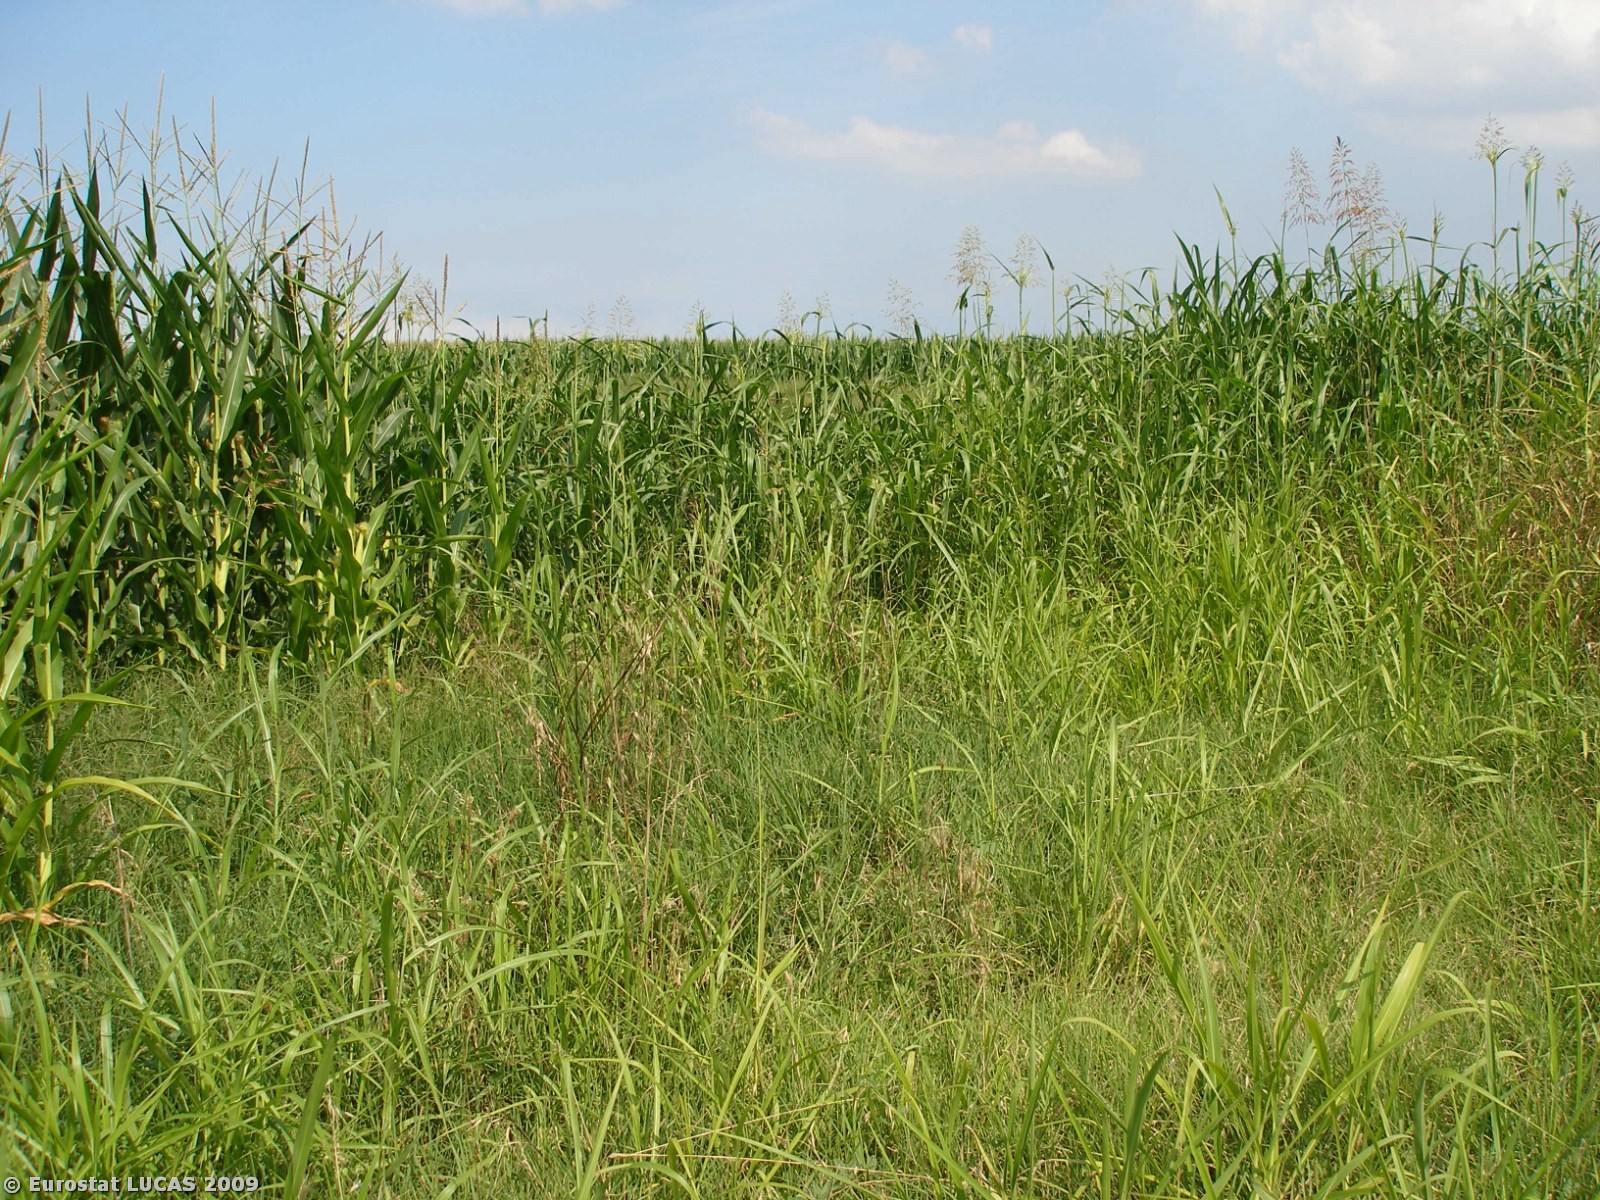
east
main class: Cropland
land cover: Maize
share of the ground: > 75 %
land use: Agriculture (excluding fallow land and kitchen gardens)
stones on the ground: < 10 %
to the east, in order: Maize; Tracks; Maize; Railways; Ditches and canals; Tracks; Maize; Ditches and canals
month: July
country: IT
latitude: 45.0695
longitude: 12.0666
